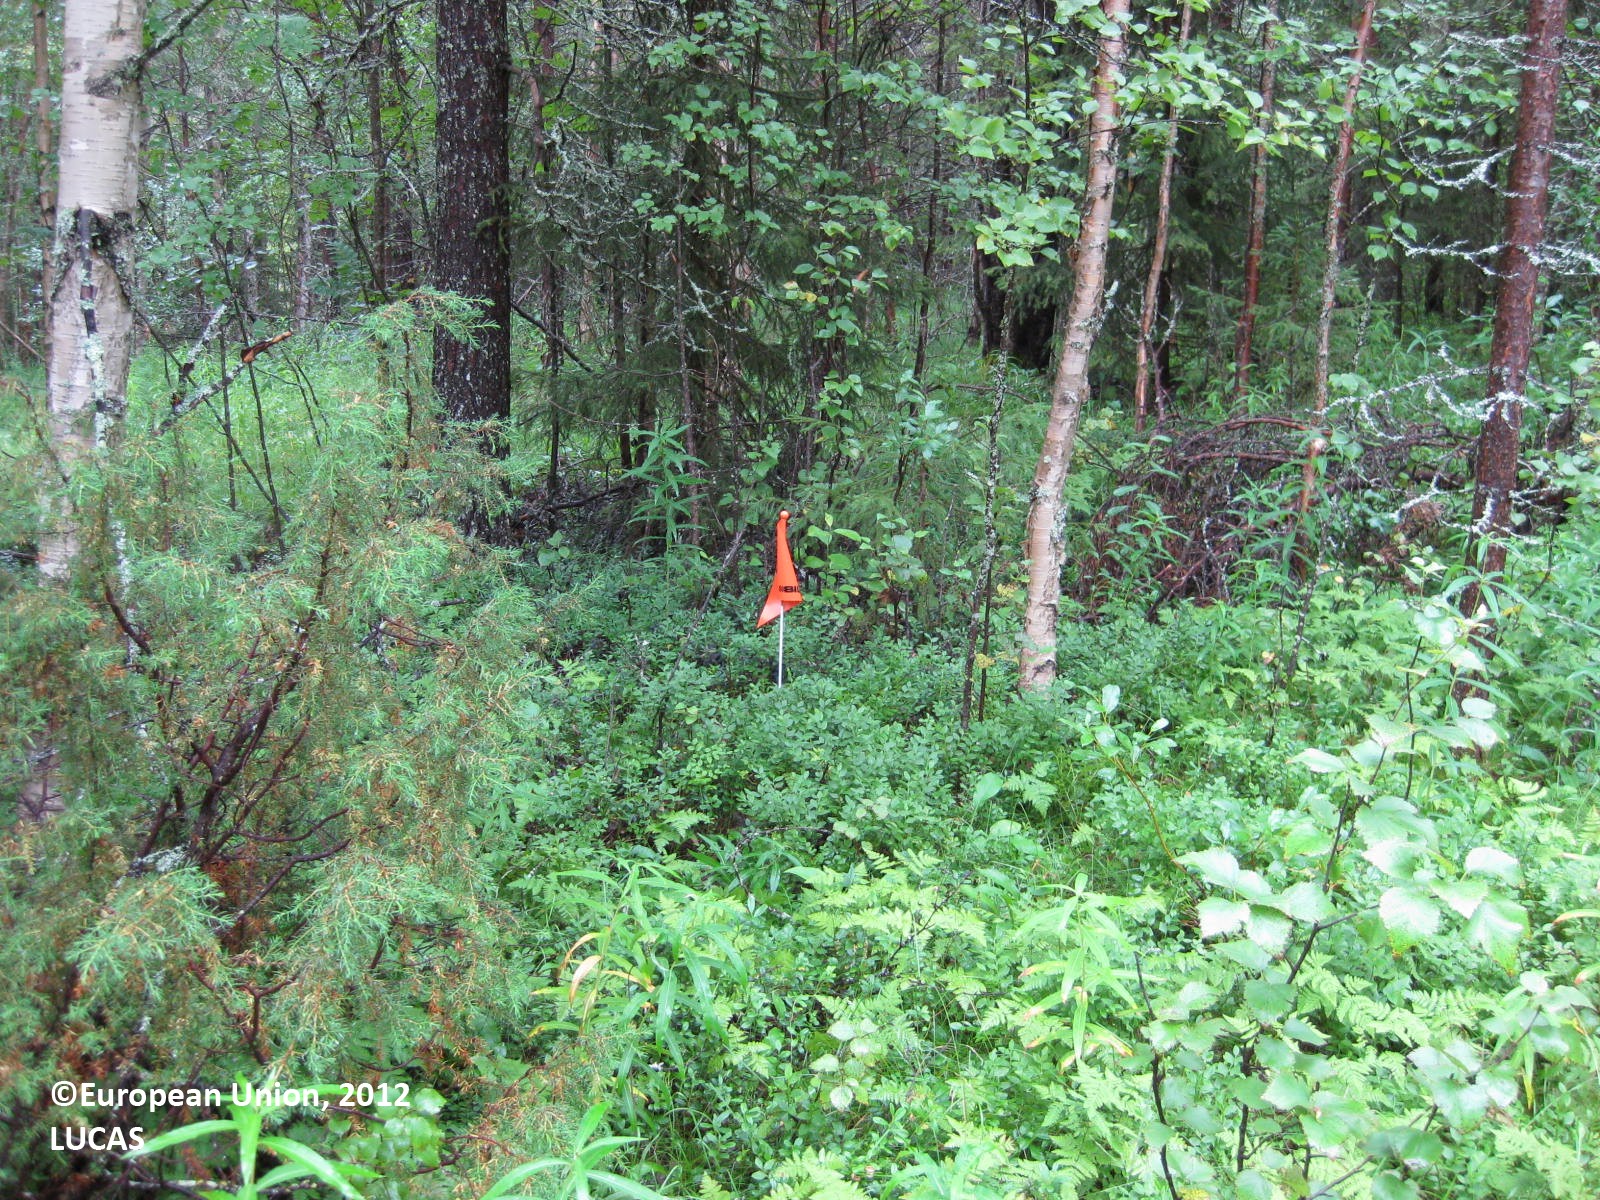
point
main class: Woodland
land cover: Other mixed woodland
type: boreal forest
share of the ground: 50 - 75 %
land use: Forestry
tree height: > 5 m
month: August
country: FI
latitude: 65.8592
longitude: 28.1341
